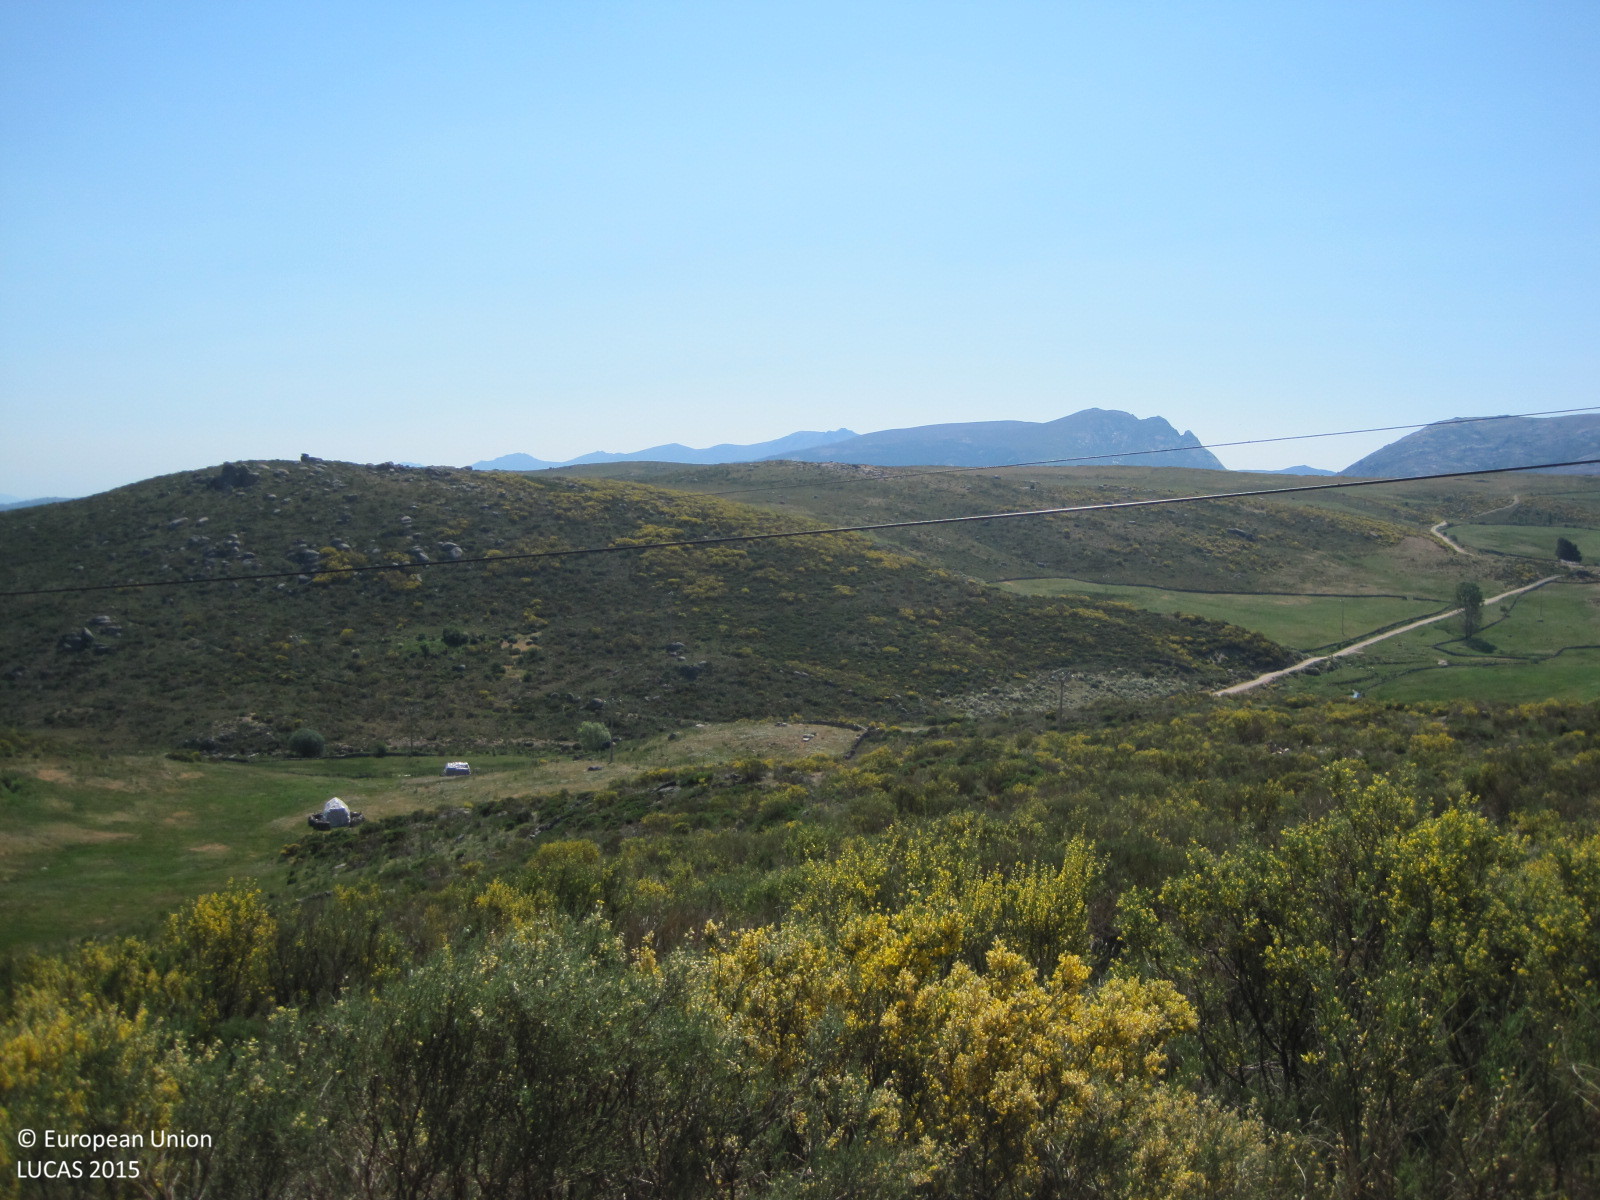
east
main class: Woodland
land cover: Pine dominated coniferous woodland
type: coniferous forest of the mediterranean region
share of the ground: 50 - 75 %
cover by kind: coniferous forest trees 45 %, consolidated bare surface 20 %, unconsolidated bare surface 20 %, herbaceous plants 10 %
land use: Semi-natural and natural areas not in use
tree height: > 5 m
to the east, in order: Pine dominated coniferous woodland; Rocks and stones; Tracks; Rocks and stones; Tracks; Rocks and stones
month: June
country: ES
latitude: 40.3273
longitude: -5.0633
